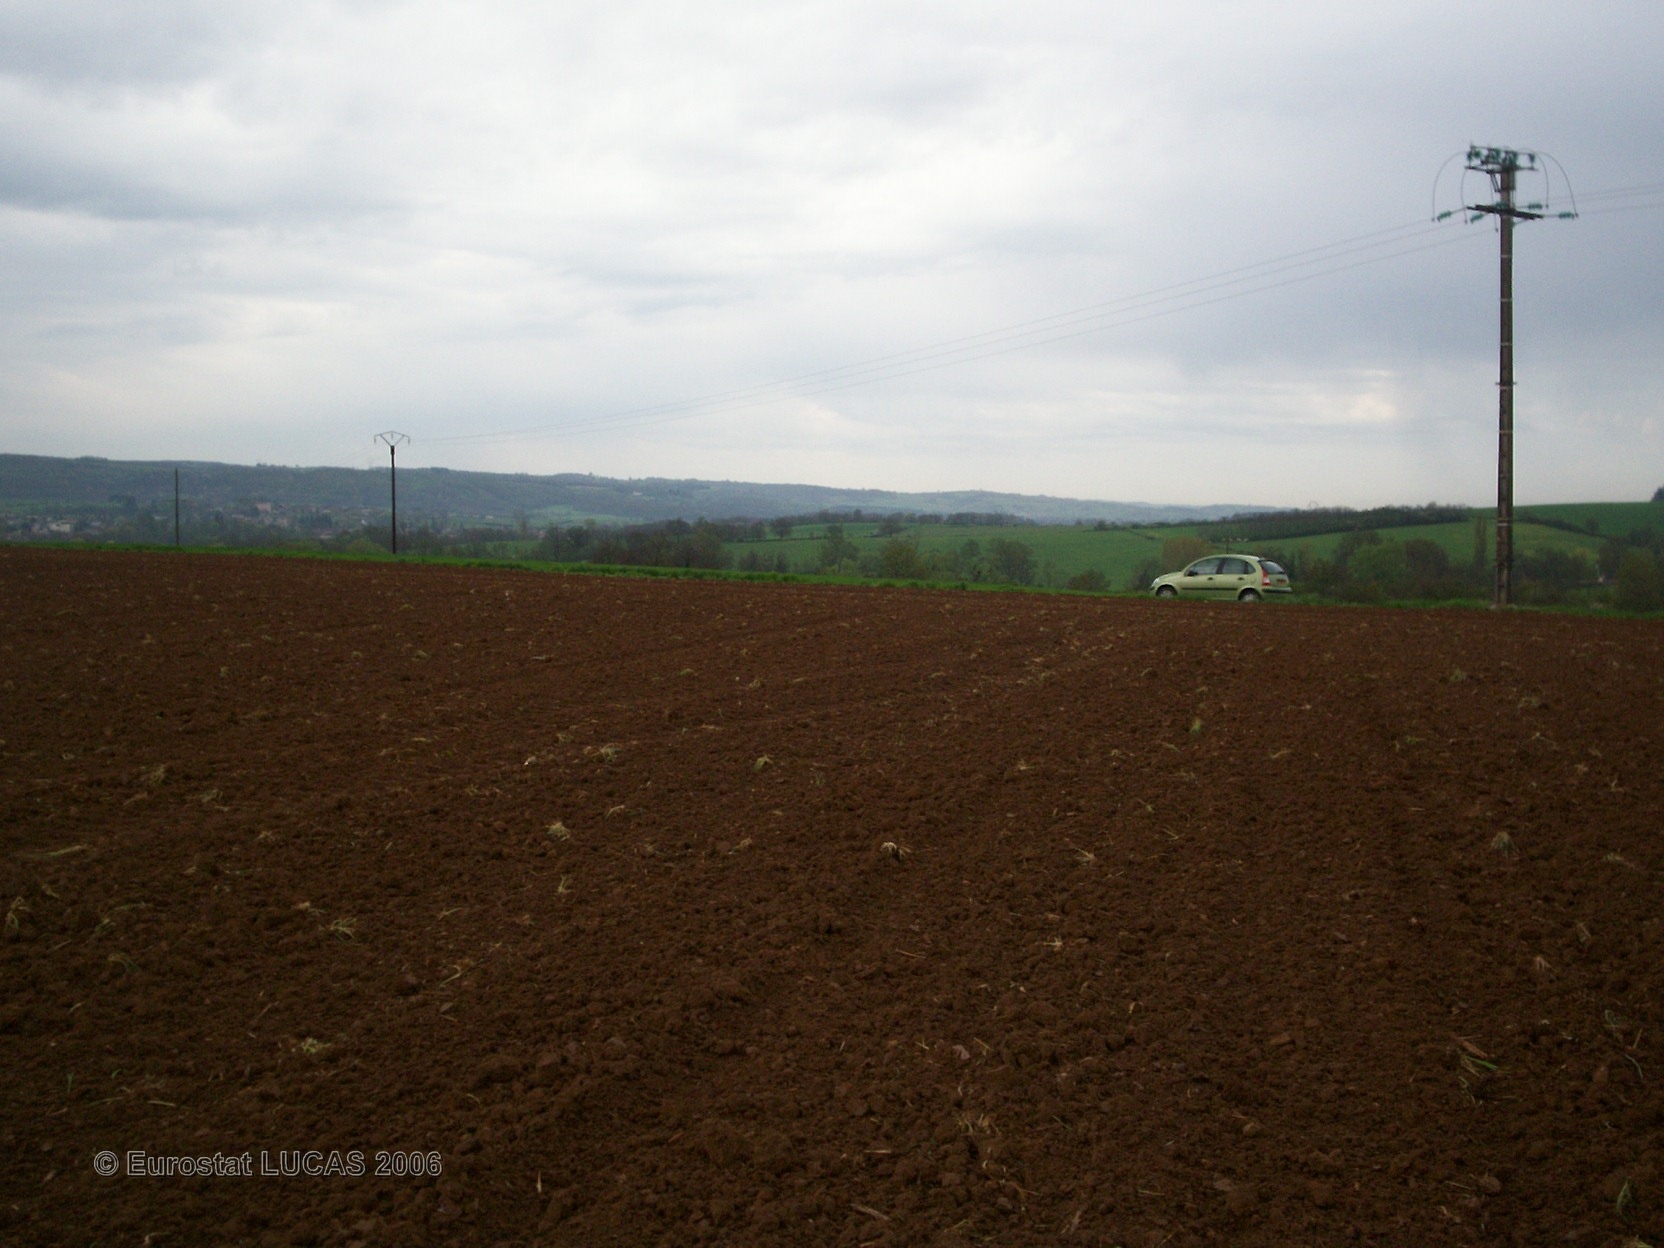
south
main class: Cropland
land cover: Sunflower
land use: Agriculture (excluding fallow land and kitchen gardens)
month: May
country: FR
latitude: 46.8663
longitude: 4.6353
